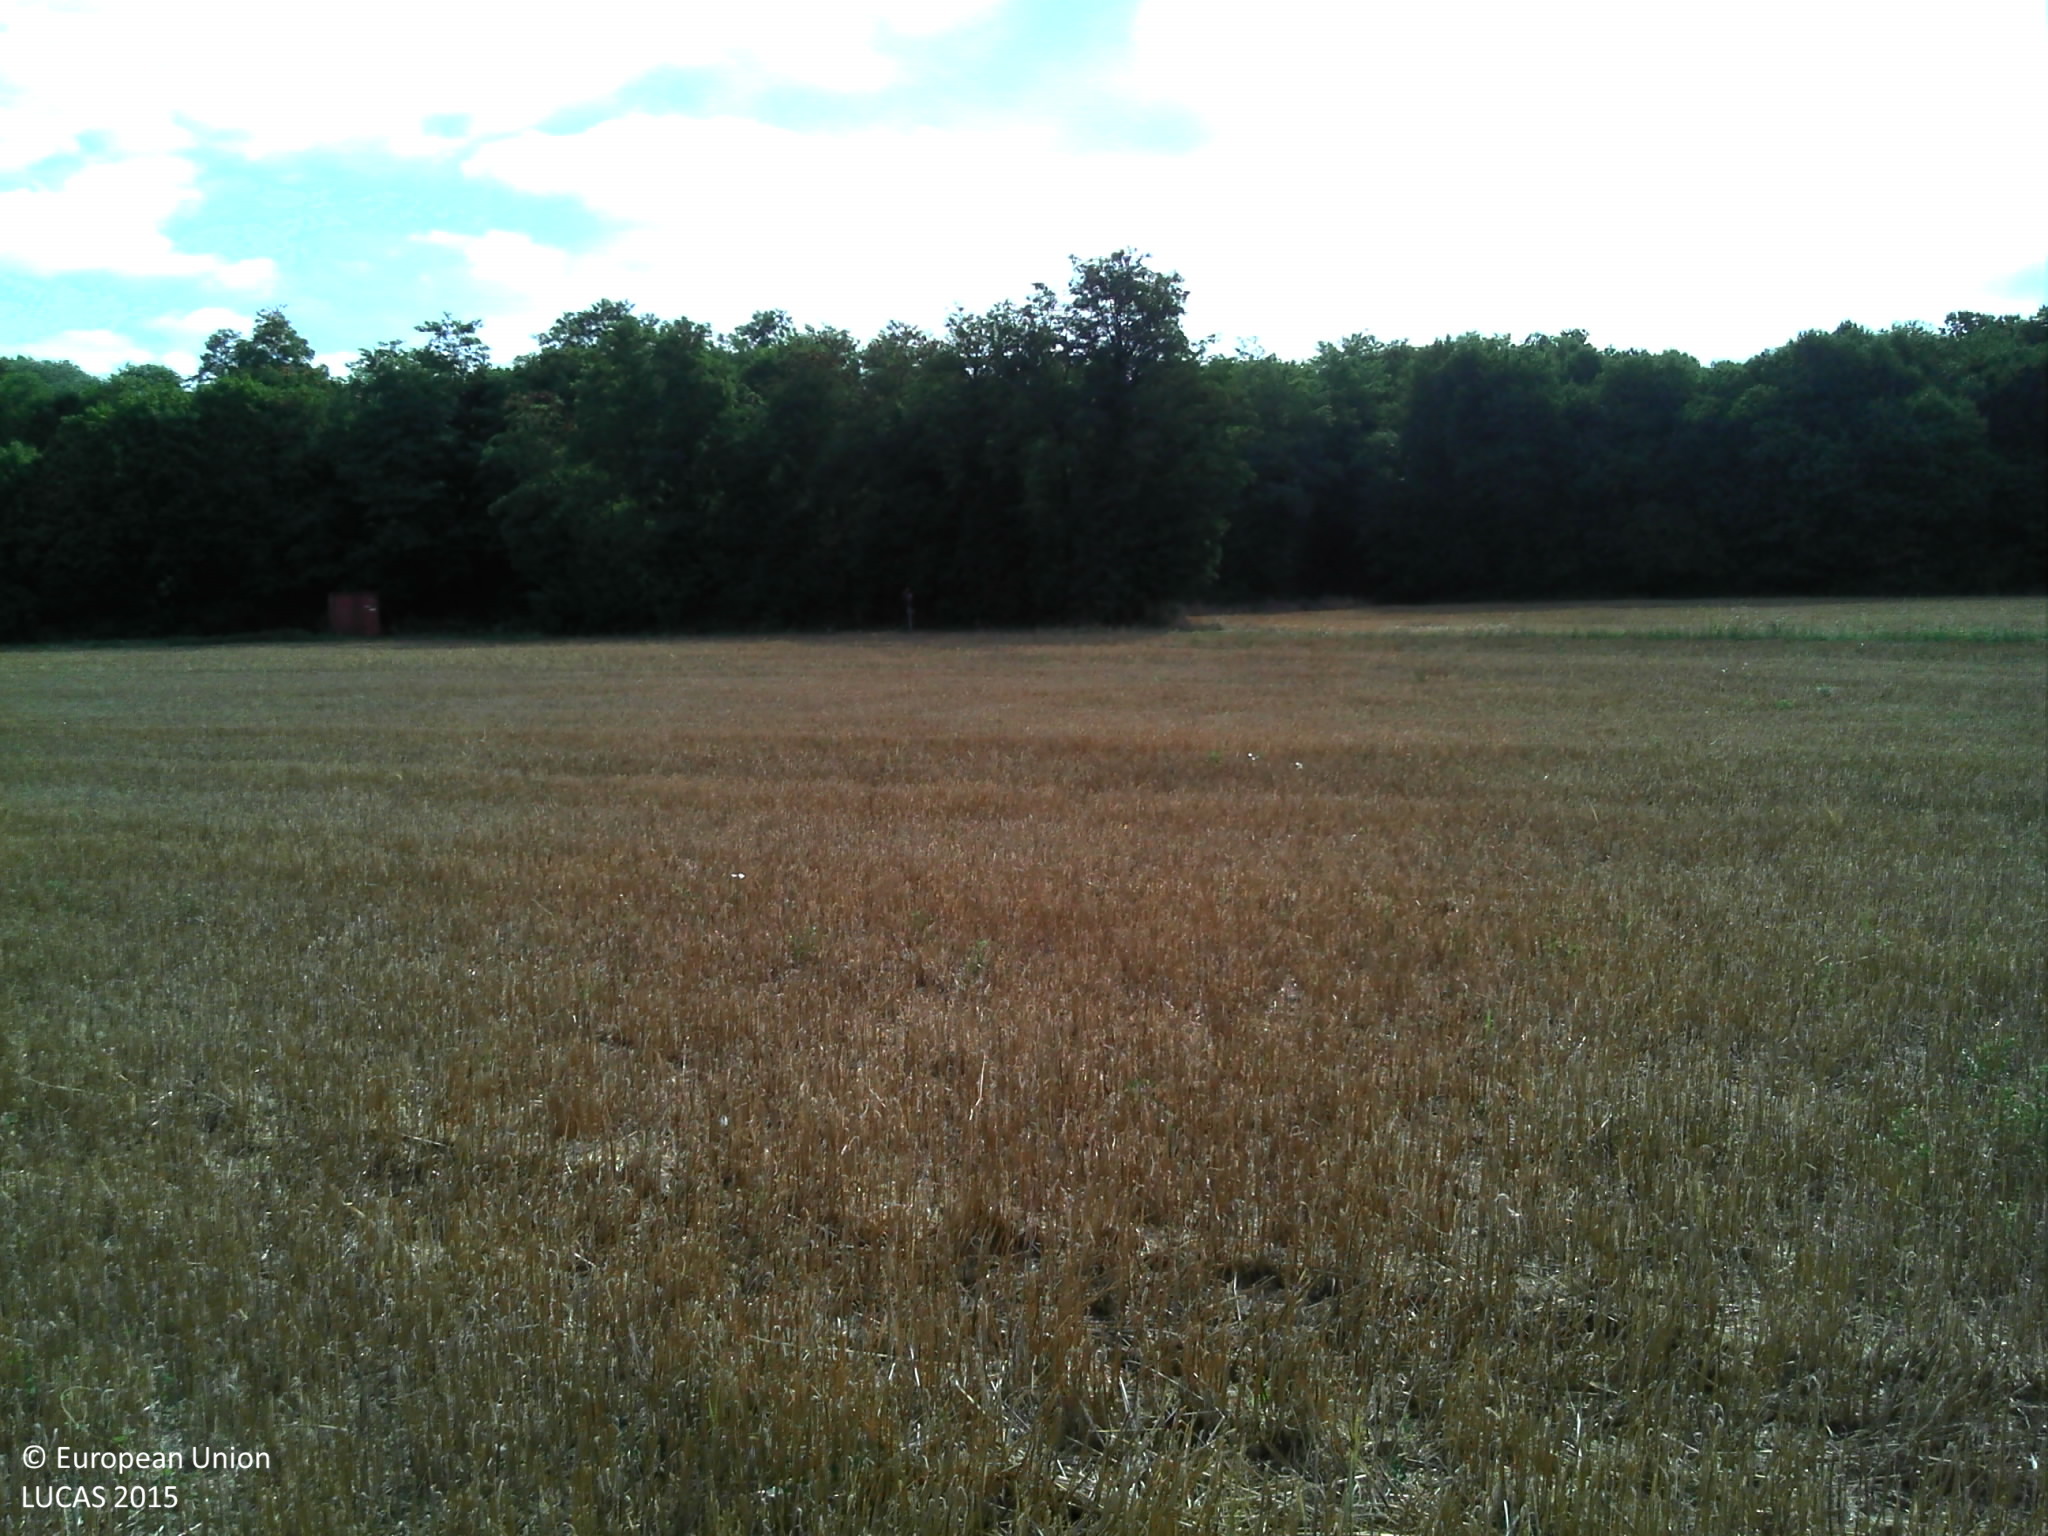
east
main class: Cropland
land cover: Common wheat
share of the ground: > 75 %
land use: Agriculture (excluding fallow land and kitchen gardens)
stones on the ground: 10 - 25 %
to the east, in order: Common wheat; Grass margins; Paved roads, cycling and walking lanes; Grass margins; Managed hedges; Common wheat; Grass margins; Tracks; Broadleaved woodland; Grass margins; Paved roads, cycling and walking lanes; Grass margins; Grassland with sparse tree/shrub cover; Broadleaved woodland; Electric lines; Railways; Electric lines; Managed hedges; Grassland without tree/shrub cover
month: August
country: FR
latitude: 46.2664
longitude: 0.2373
